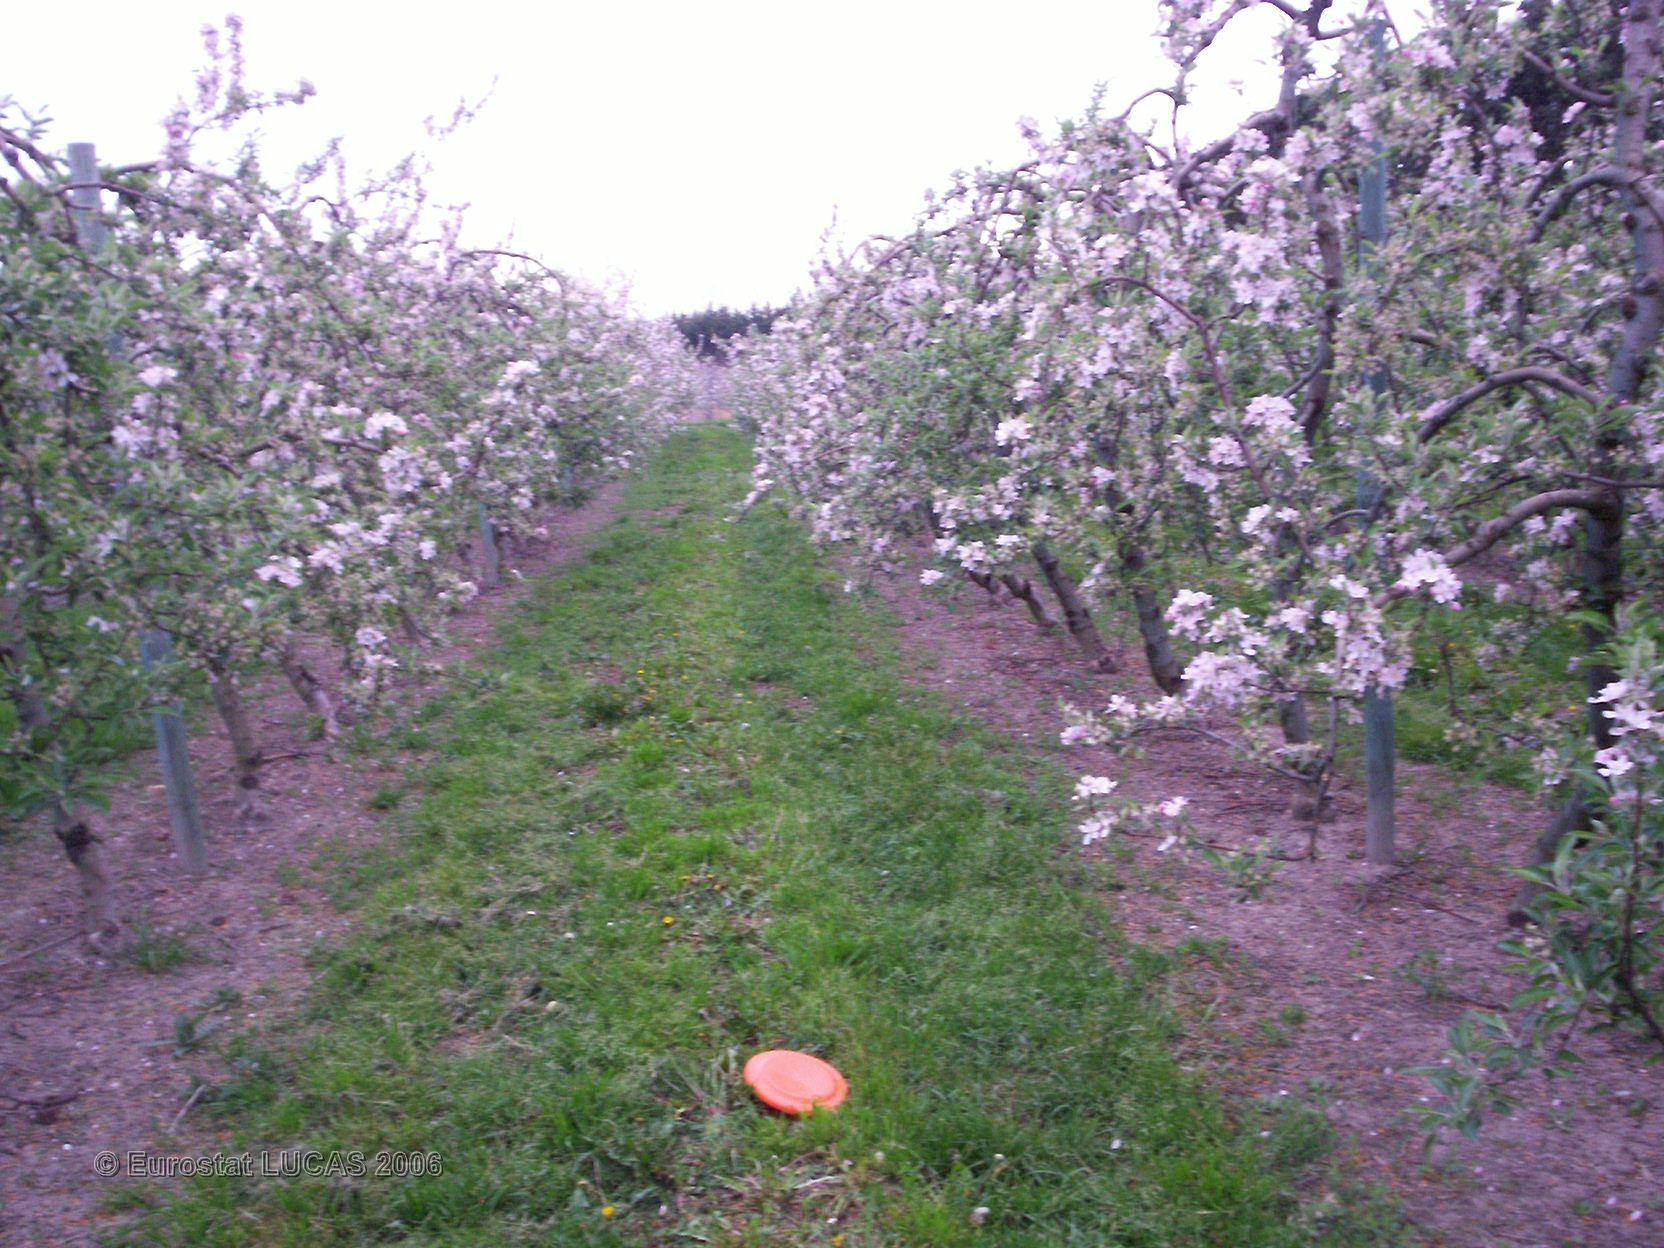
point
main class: Cropland
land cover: Apple fruit
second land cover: Grassland with sparse tree/shrub cover
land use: Agriculture (excluding fallow land and kitchen gardens)
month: April
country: FR
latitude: 43.8647
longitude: 4.9198
